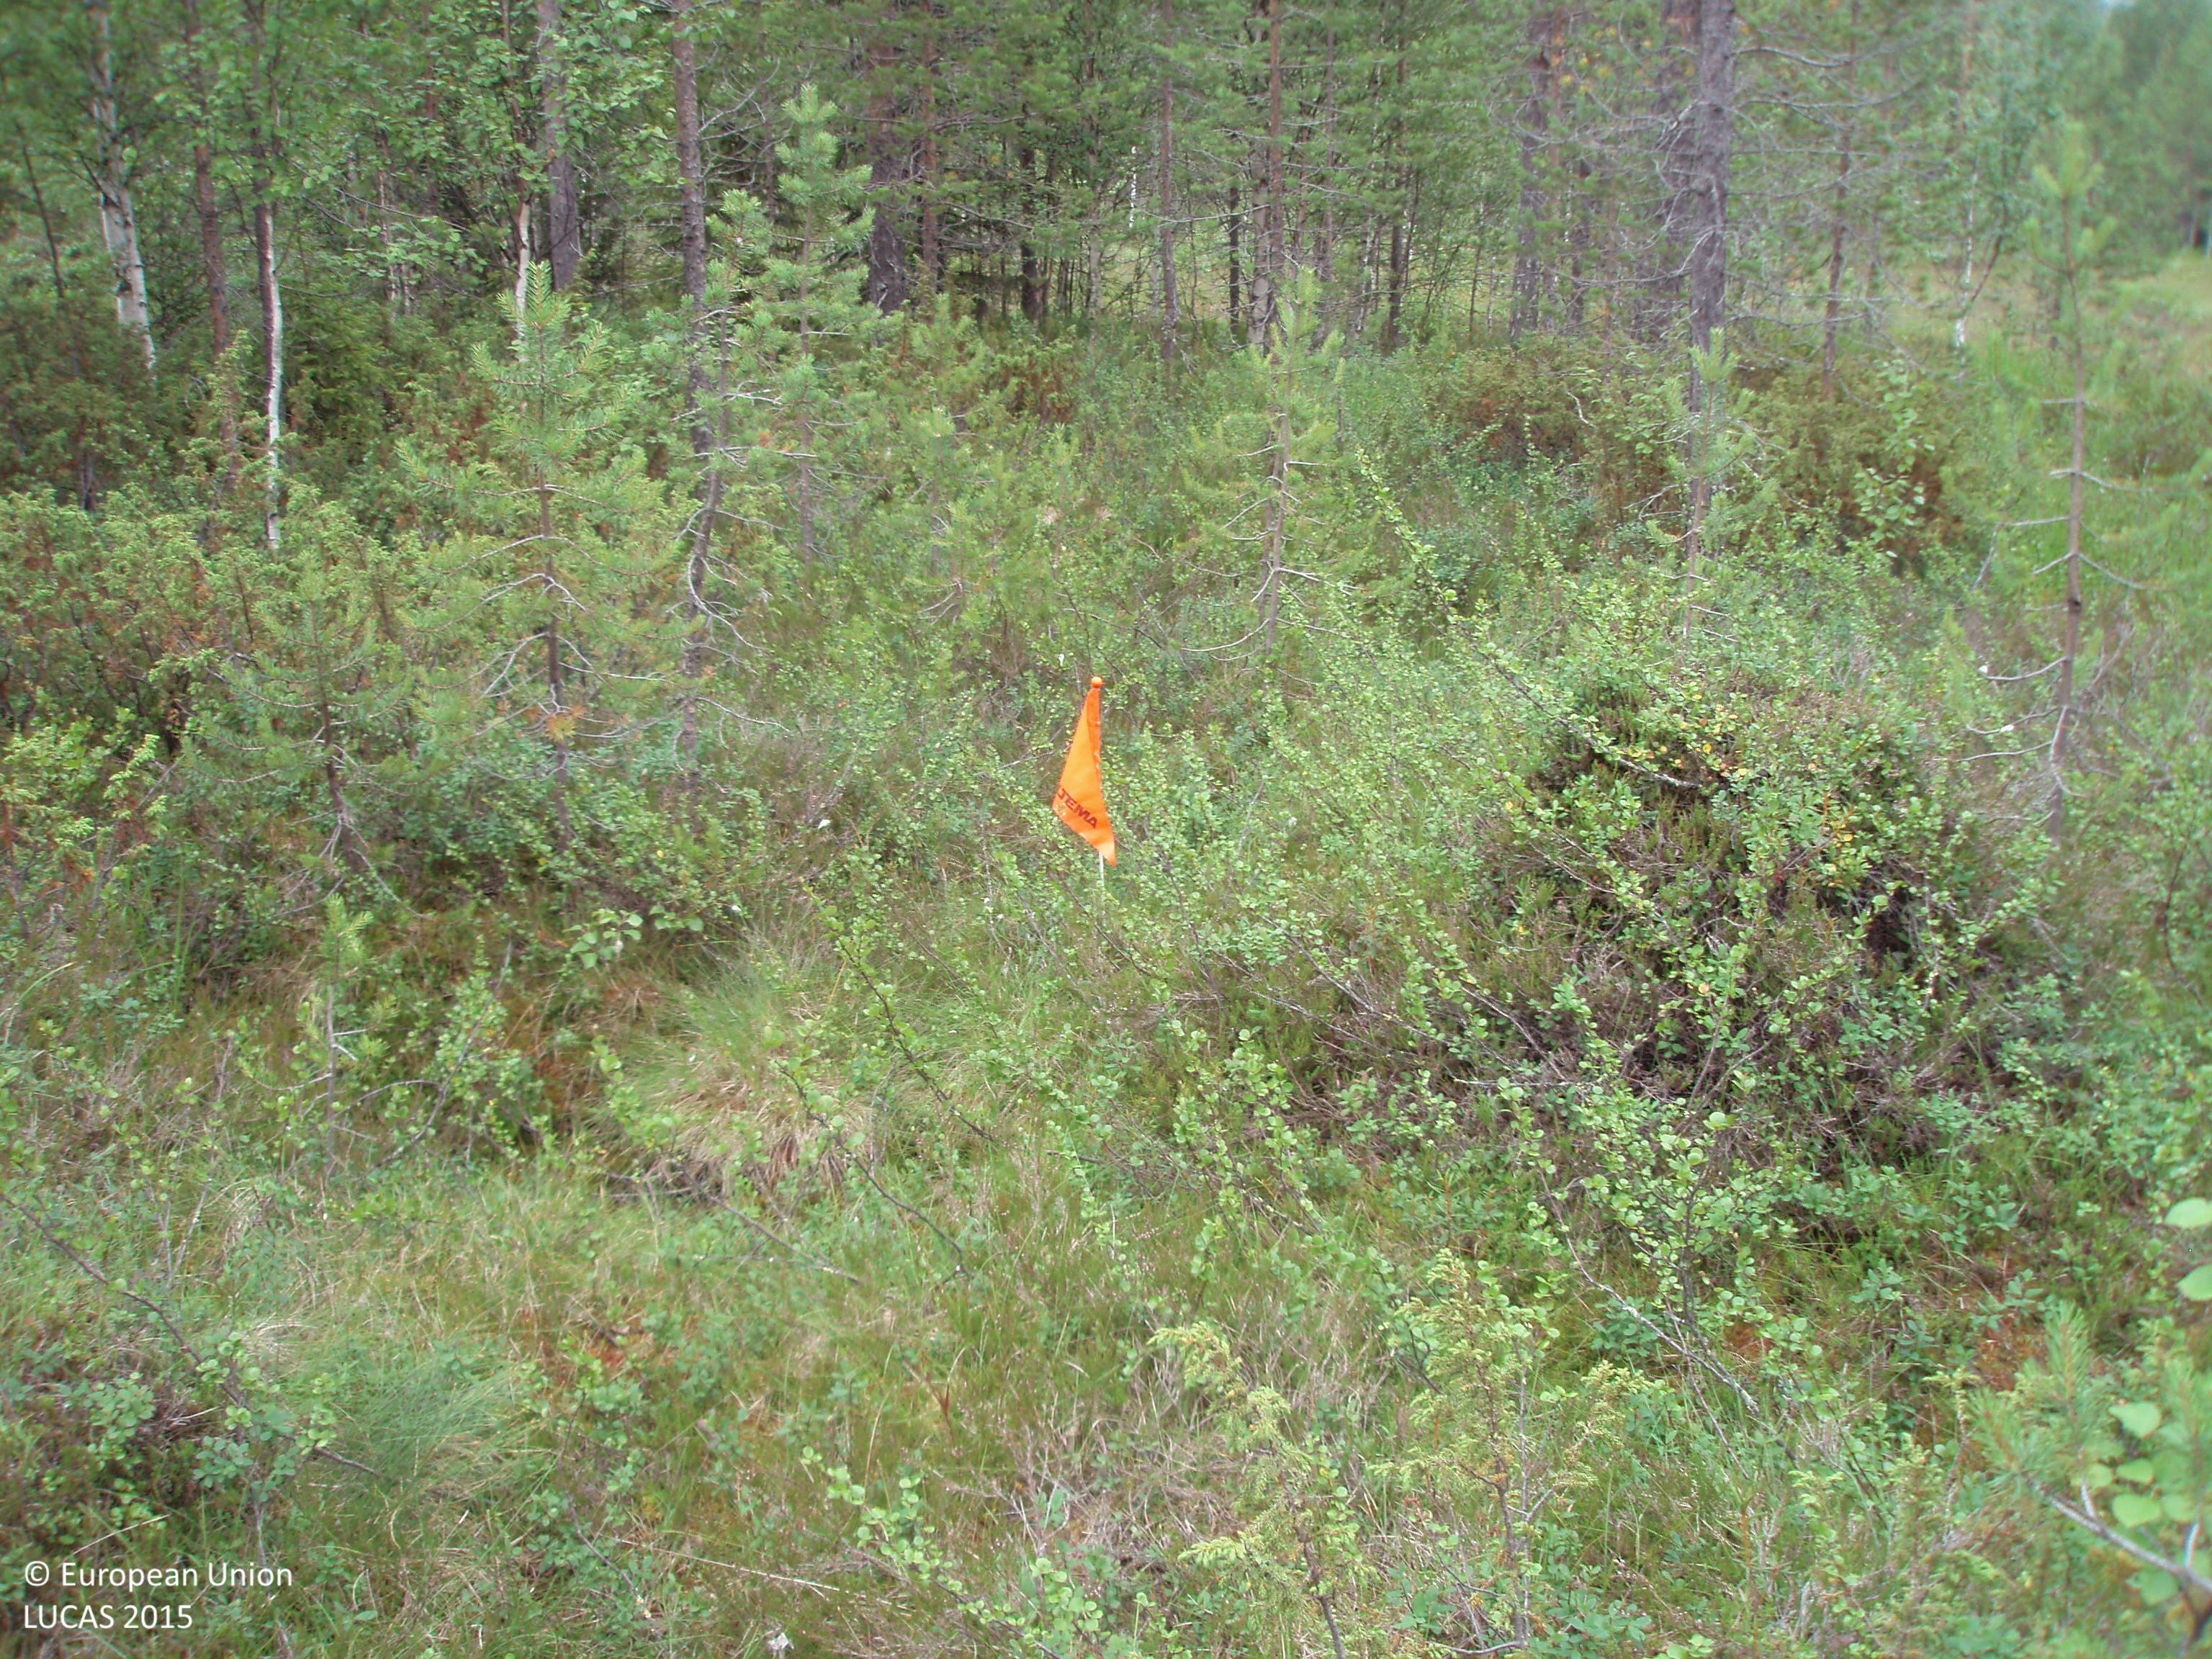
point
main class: Woodland
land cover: Other mixed woodland
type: boreal forest
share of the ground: 25 - 50 %
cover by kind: shrubs 40 %, coniferous forest trees 25 %, broadleaved forest trees 20 %, herbaceous plants 10 %, lichens and mosses 5 %
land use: Forestry
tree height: > 5 m
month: July
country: FI
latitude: 65.6219
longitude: 27.7438
